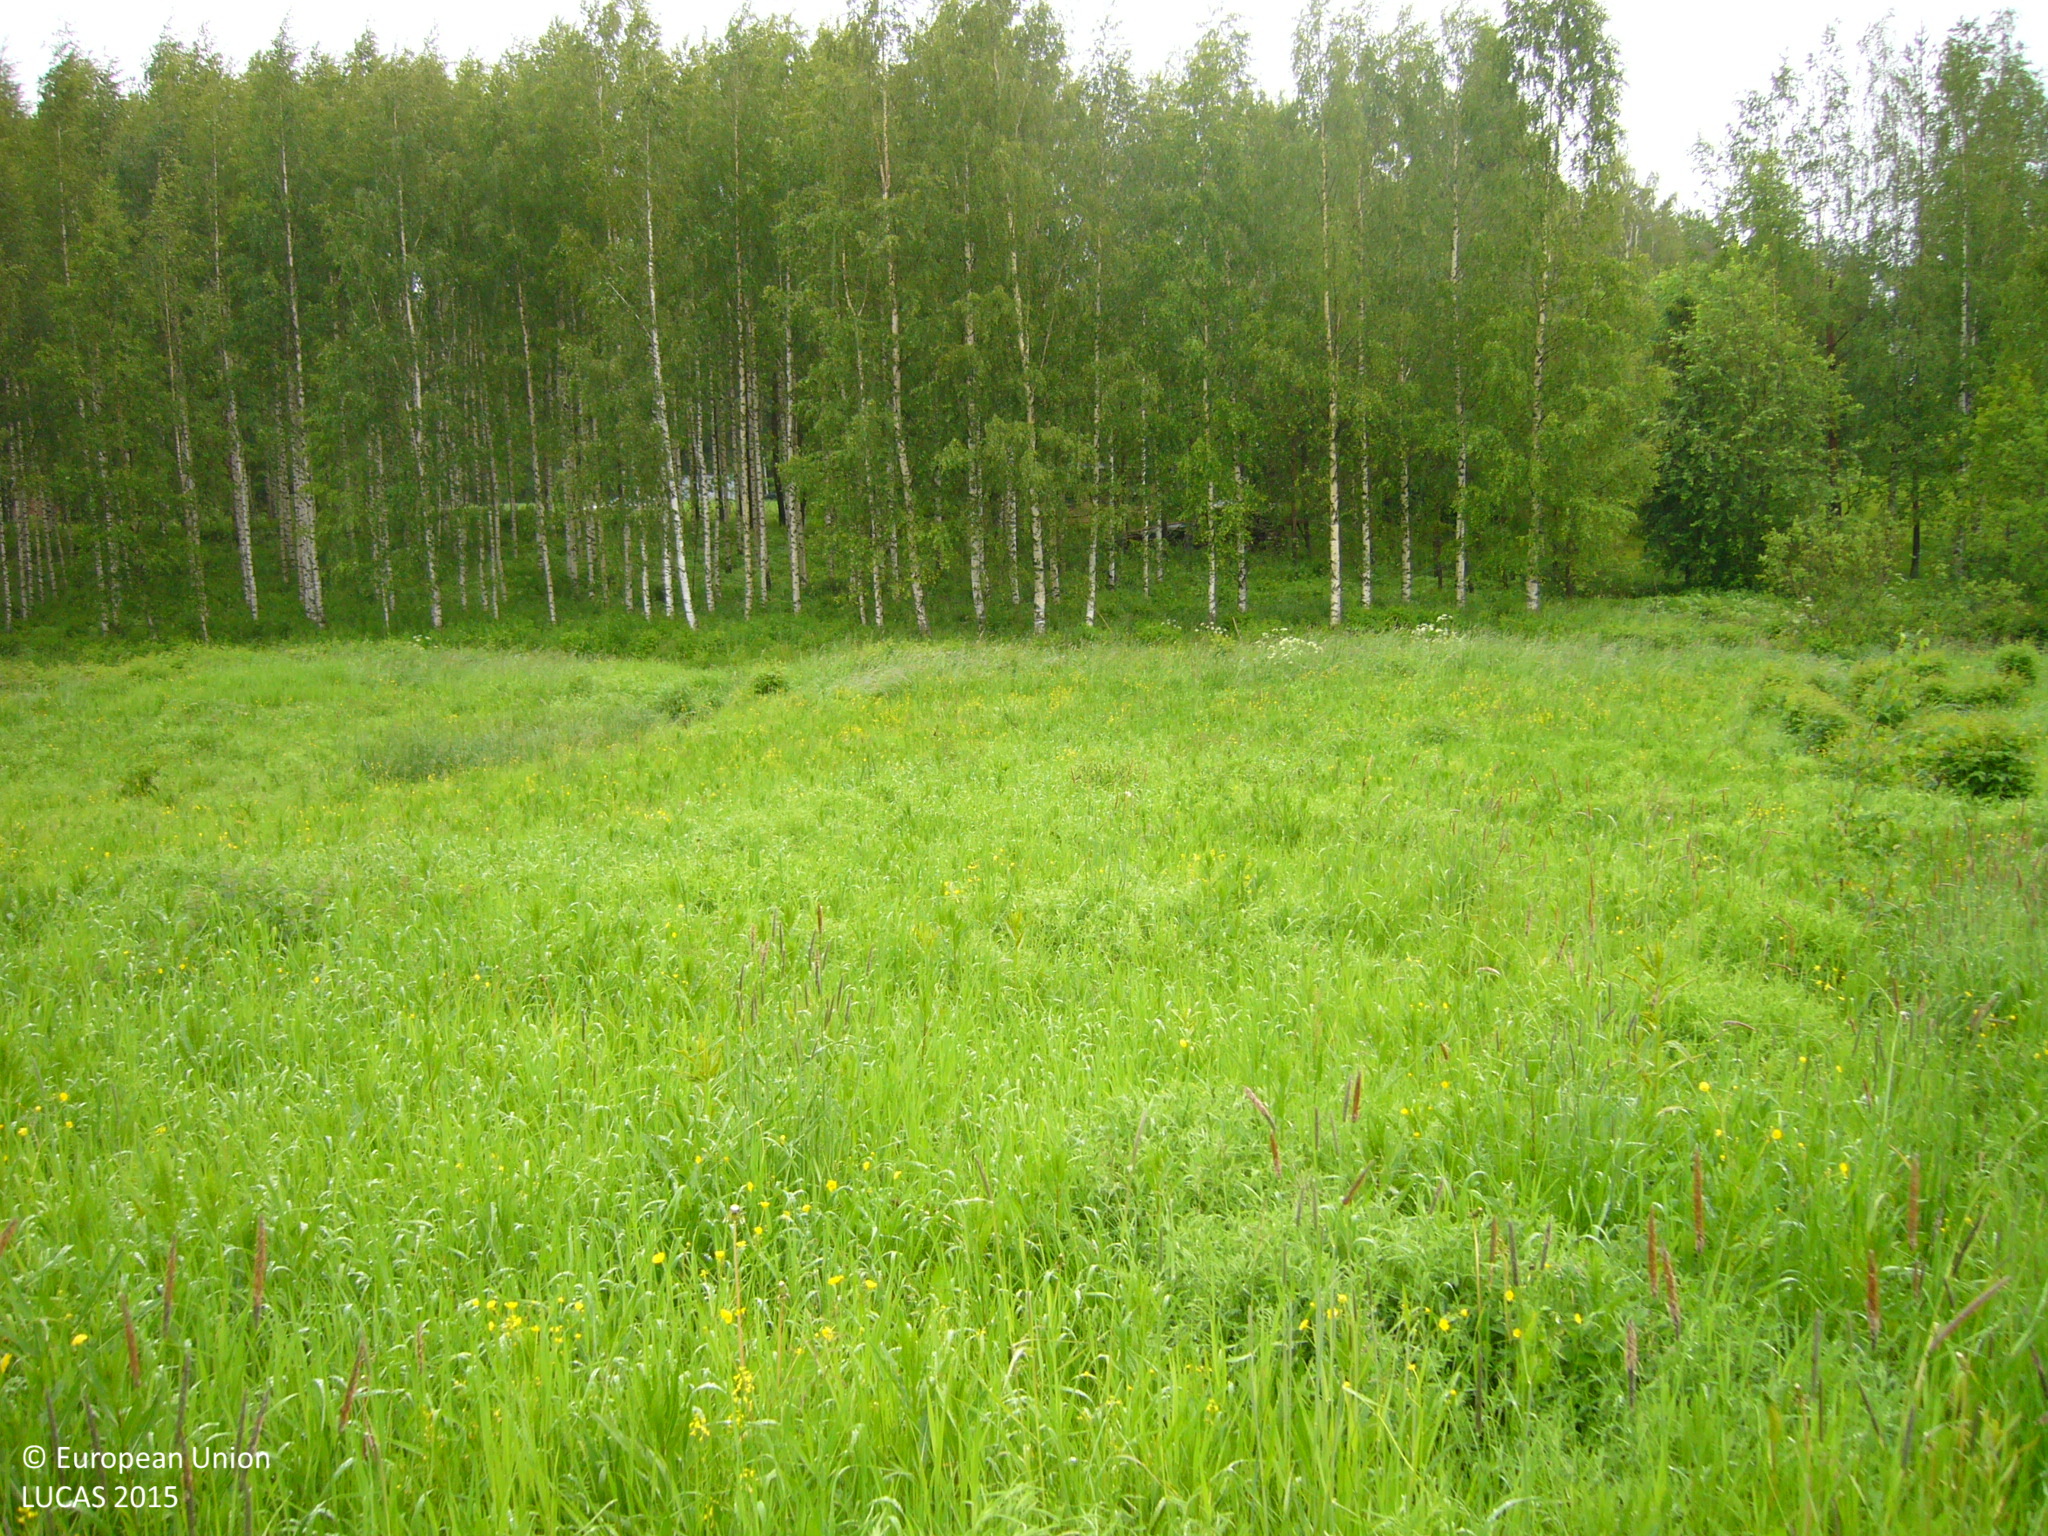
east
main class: Grassland
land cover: Grassland without tree/shrub cover
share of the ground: > 75 %
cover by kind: herbaceous plants 100 %
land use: Agriculture (excluding fallow land and kitchen gardens)
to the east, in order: Grassland without tree/shrub cover; Electric lines; Grassland without tree/shrub cover; Rivers and streams; Broadleaved woodland; Grassland without tree/shrub cover; Paved roads, cycling and walking lanes; Grassland without tree/shrub cover; Pine dominated mixed woodland
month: June
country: FI
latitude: 63.8309
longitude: 25.1493
